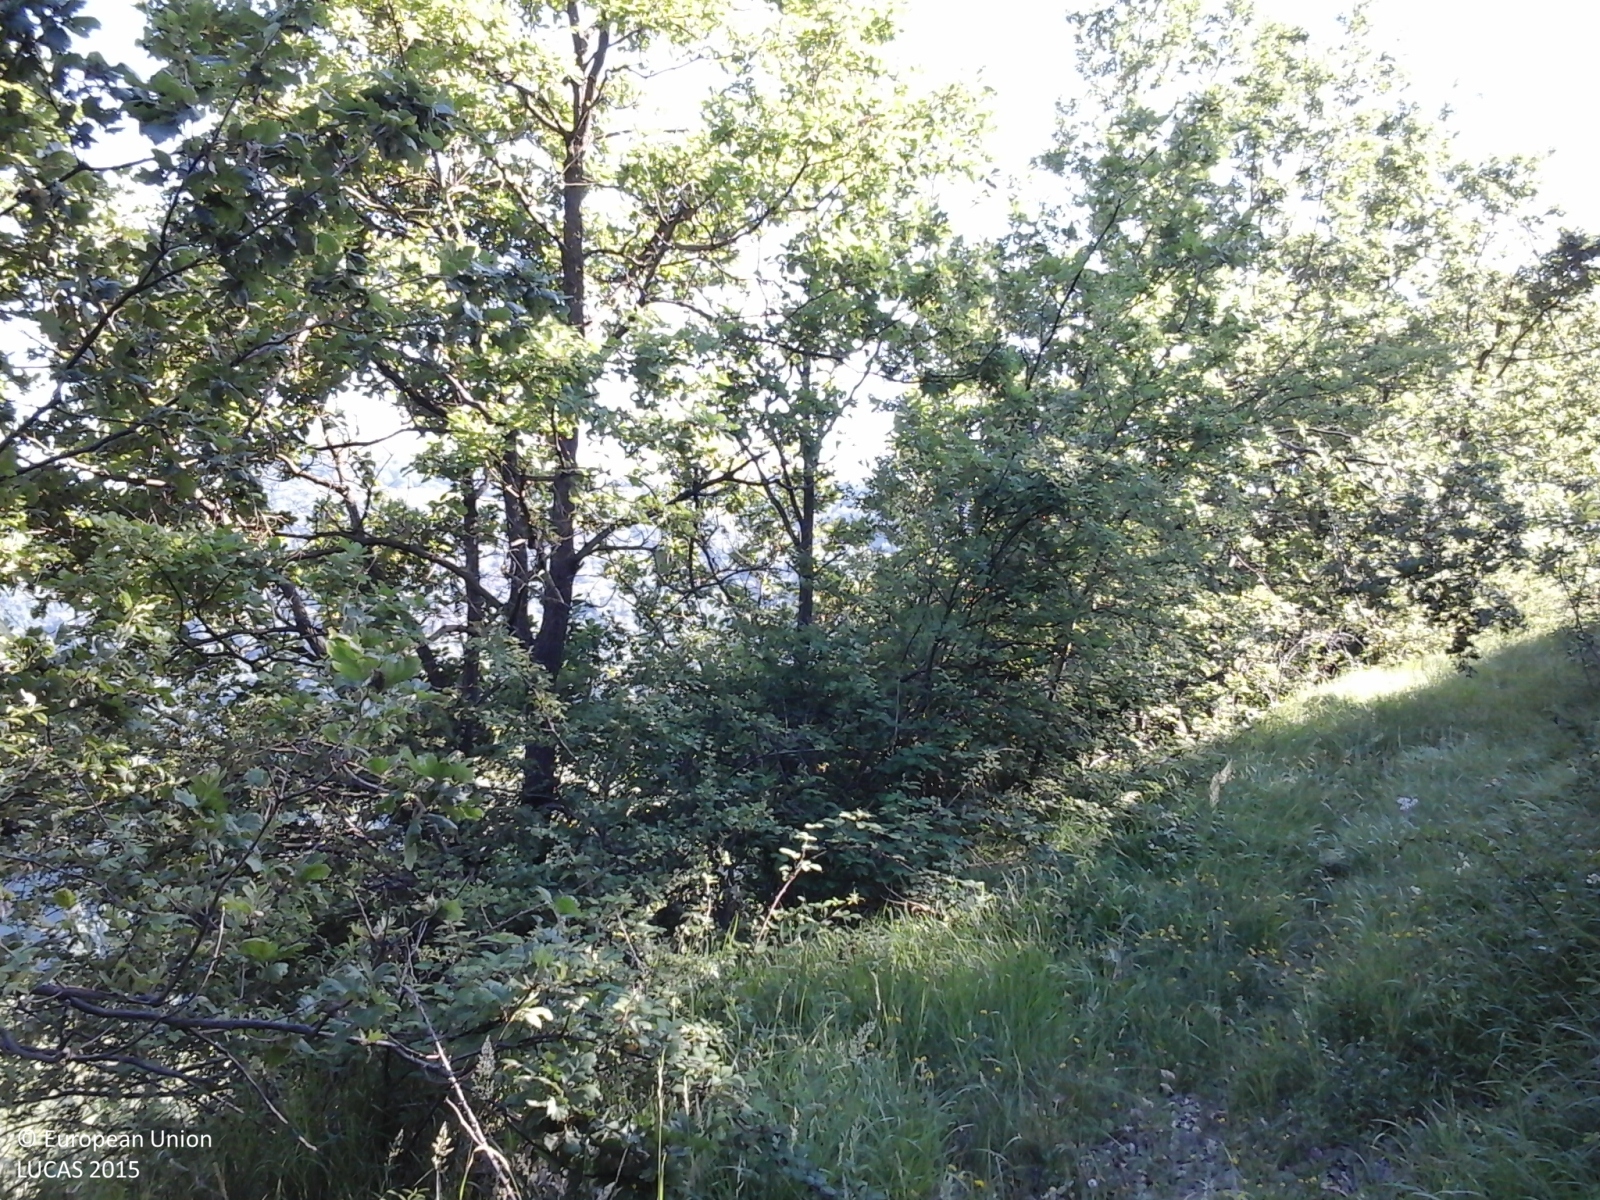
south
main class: Shrubland
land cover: Shrubland with sparse tree cover
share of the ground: > 75 %
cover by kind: shrubs 60 %, herbaceous plants 35 %, broadleaved forest trees 5 %
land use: Abandoned areas
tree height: < 5 m
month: June
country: IT
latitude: 44.5699
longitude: 8.2282
